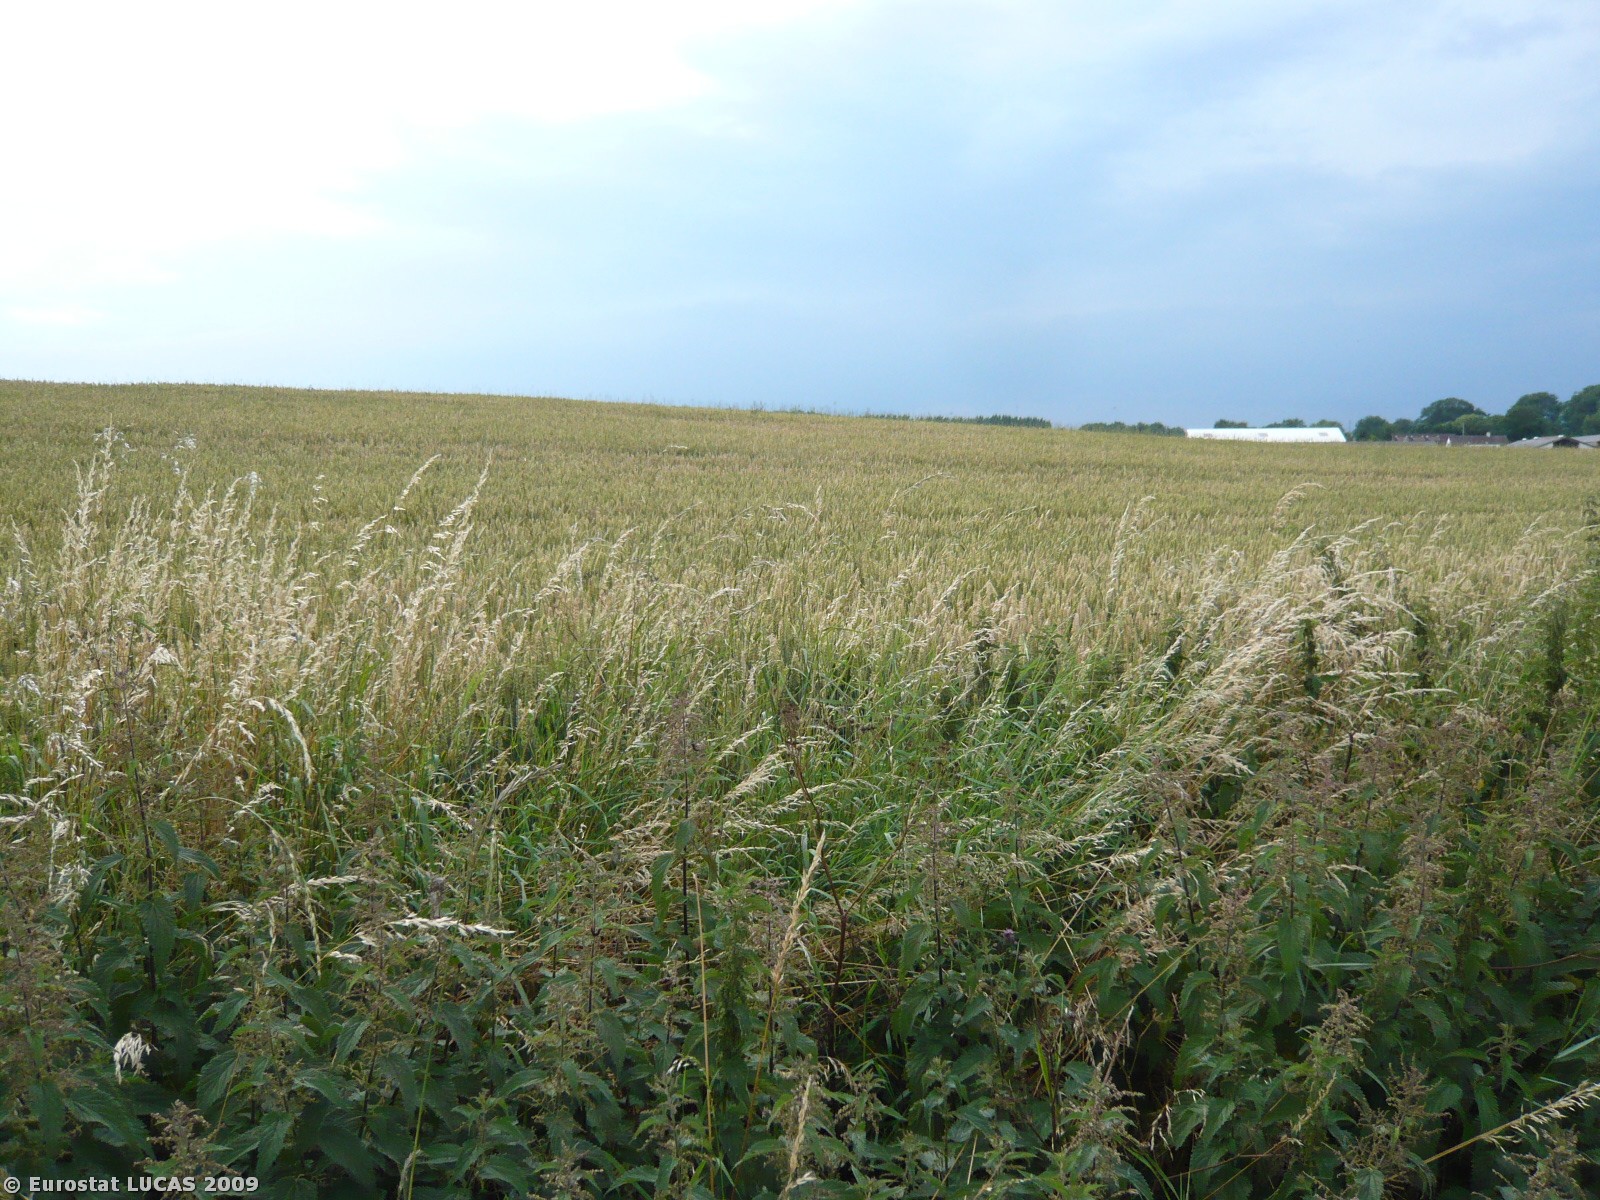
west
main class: Cropland
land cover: Common wheat
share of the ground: > 75 %
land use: Agriculture (excluding fallow land and kitchen gardens)
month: July
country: DK
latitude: 55.6945
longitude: 11.4146
